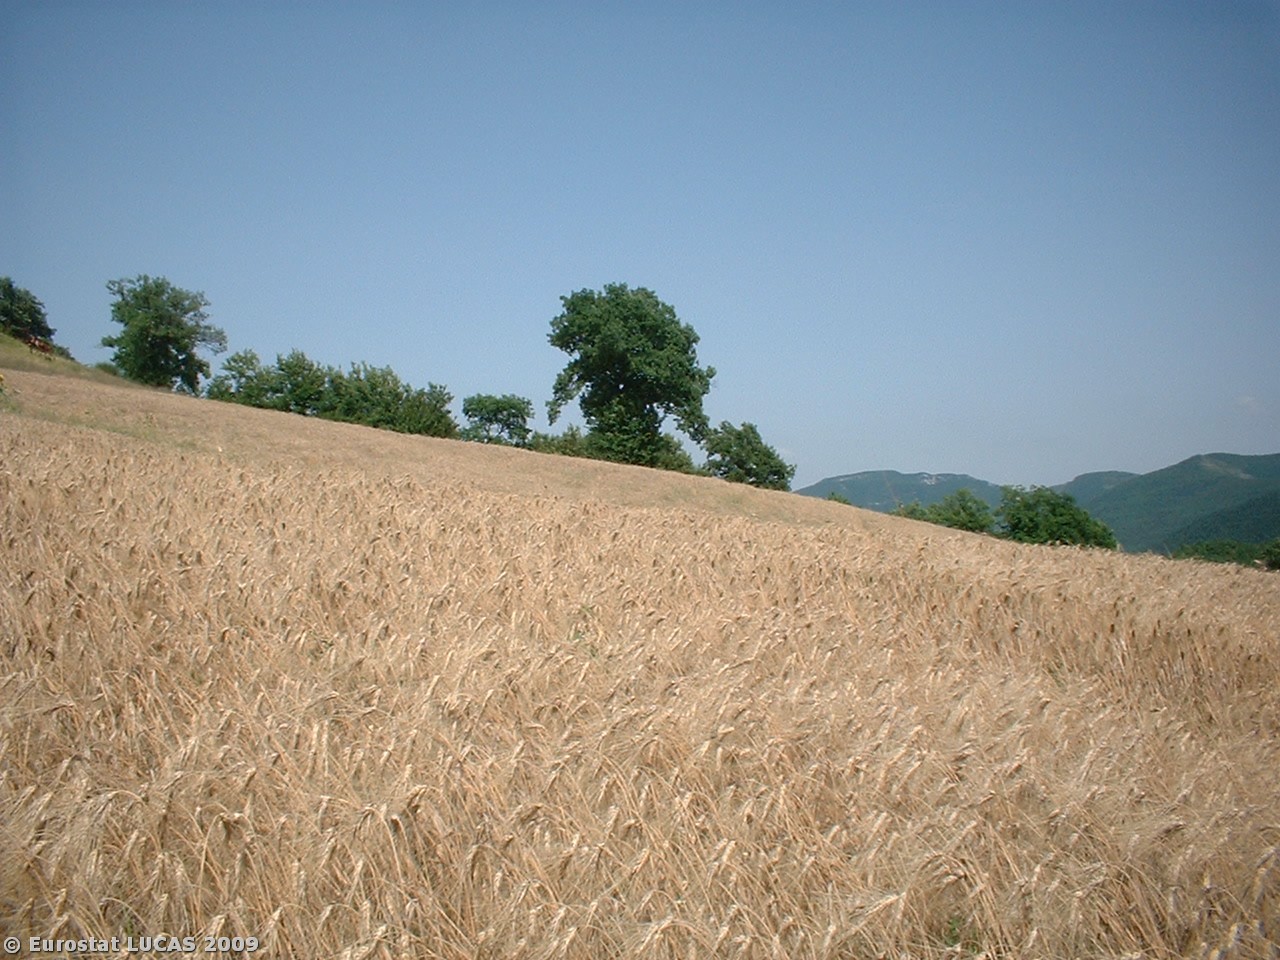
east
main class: Cropland
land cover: Durum wheat
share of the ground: > 75 %
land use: Agriculture (excluding fallow land and kitchen gardens)
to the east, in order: Durum wheat; Tracks; Durum wheat; Abandoned hedges; Durum wheat
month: July
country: IT
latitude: 43.4256
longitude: 12.8953
